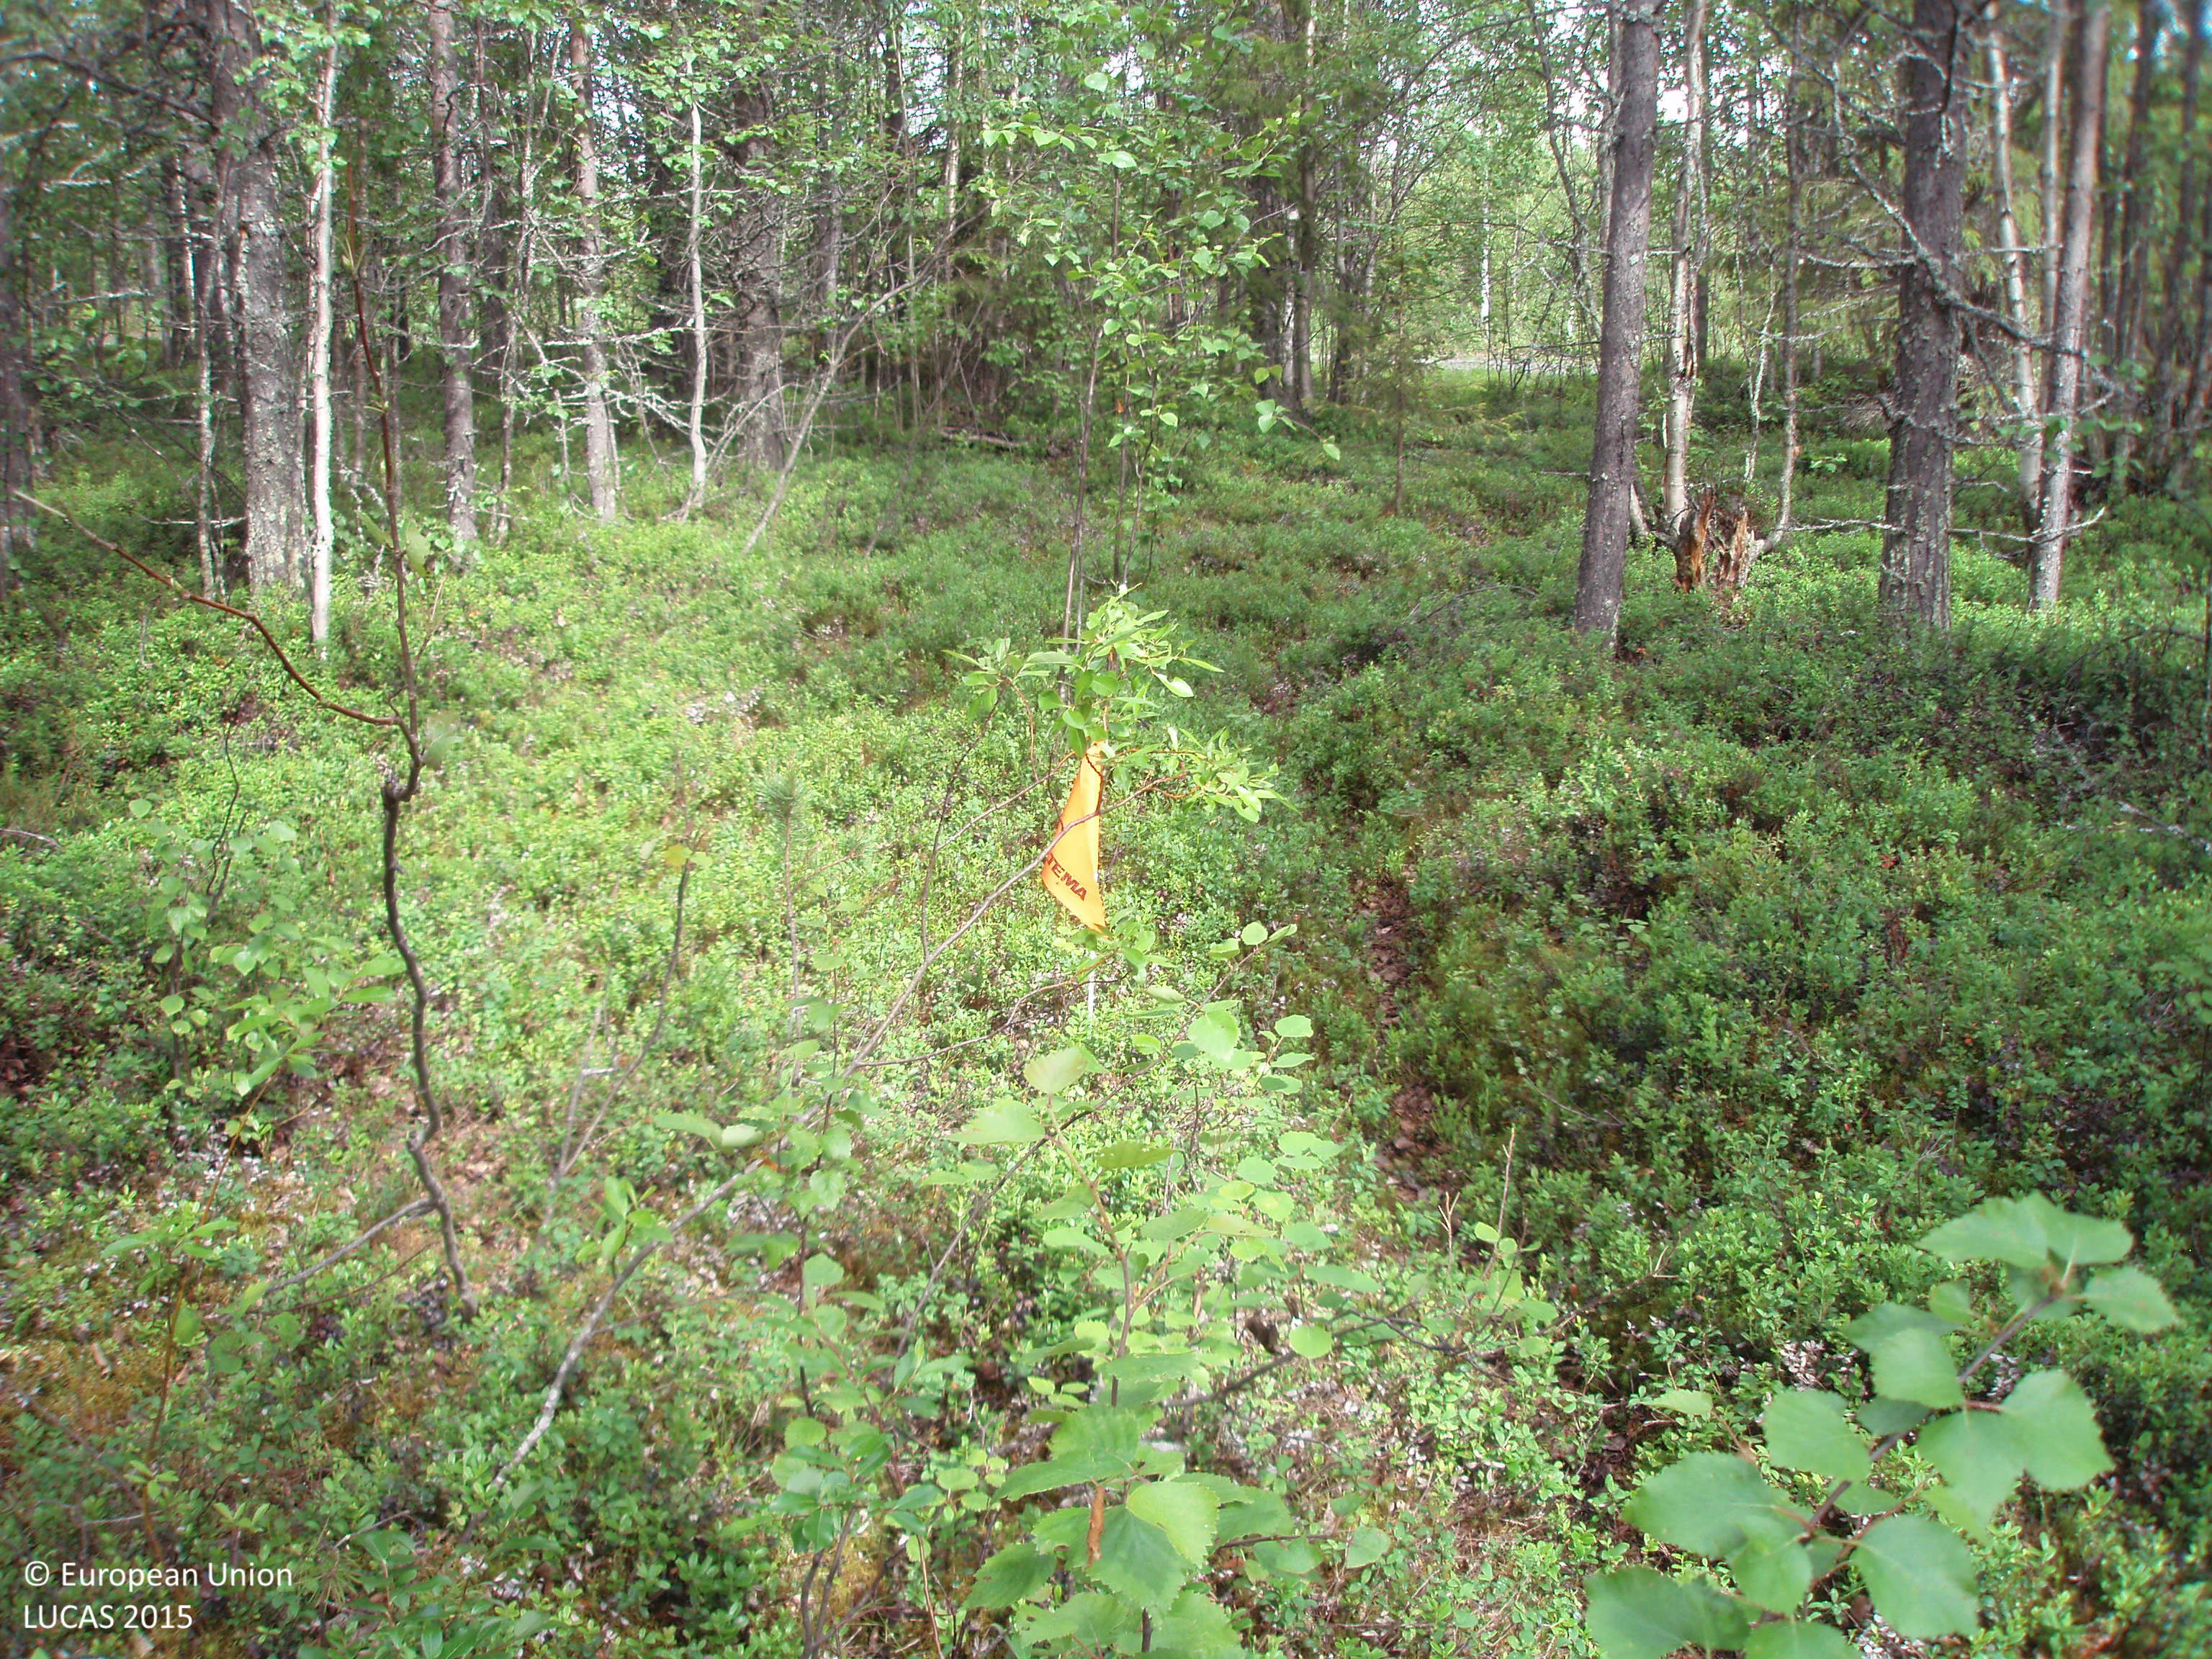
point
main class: Woodland
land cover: Pine dominated mixed woodland
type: boreal forest
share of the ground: > 75 %
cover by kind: coniferous forest trees 40 %, broadleaved forest trees 35 %, shrubs 25 %
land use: Forestry
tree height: > 5 m
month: July
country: FI
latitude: 66.9890
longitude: 28.0734
